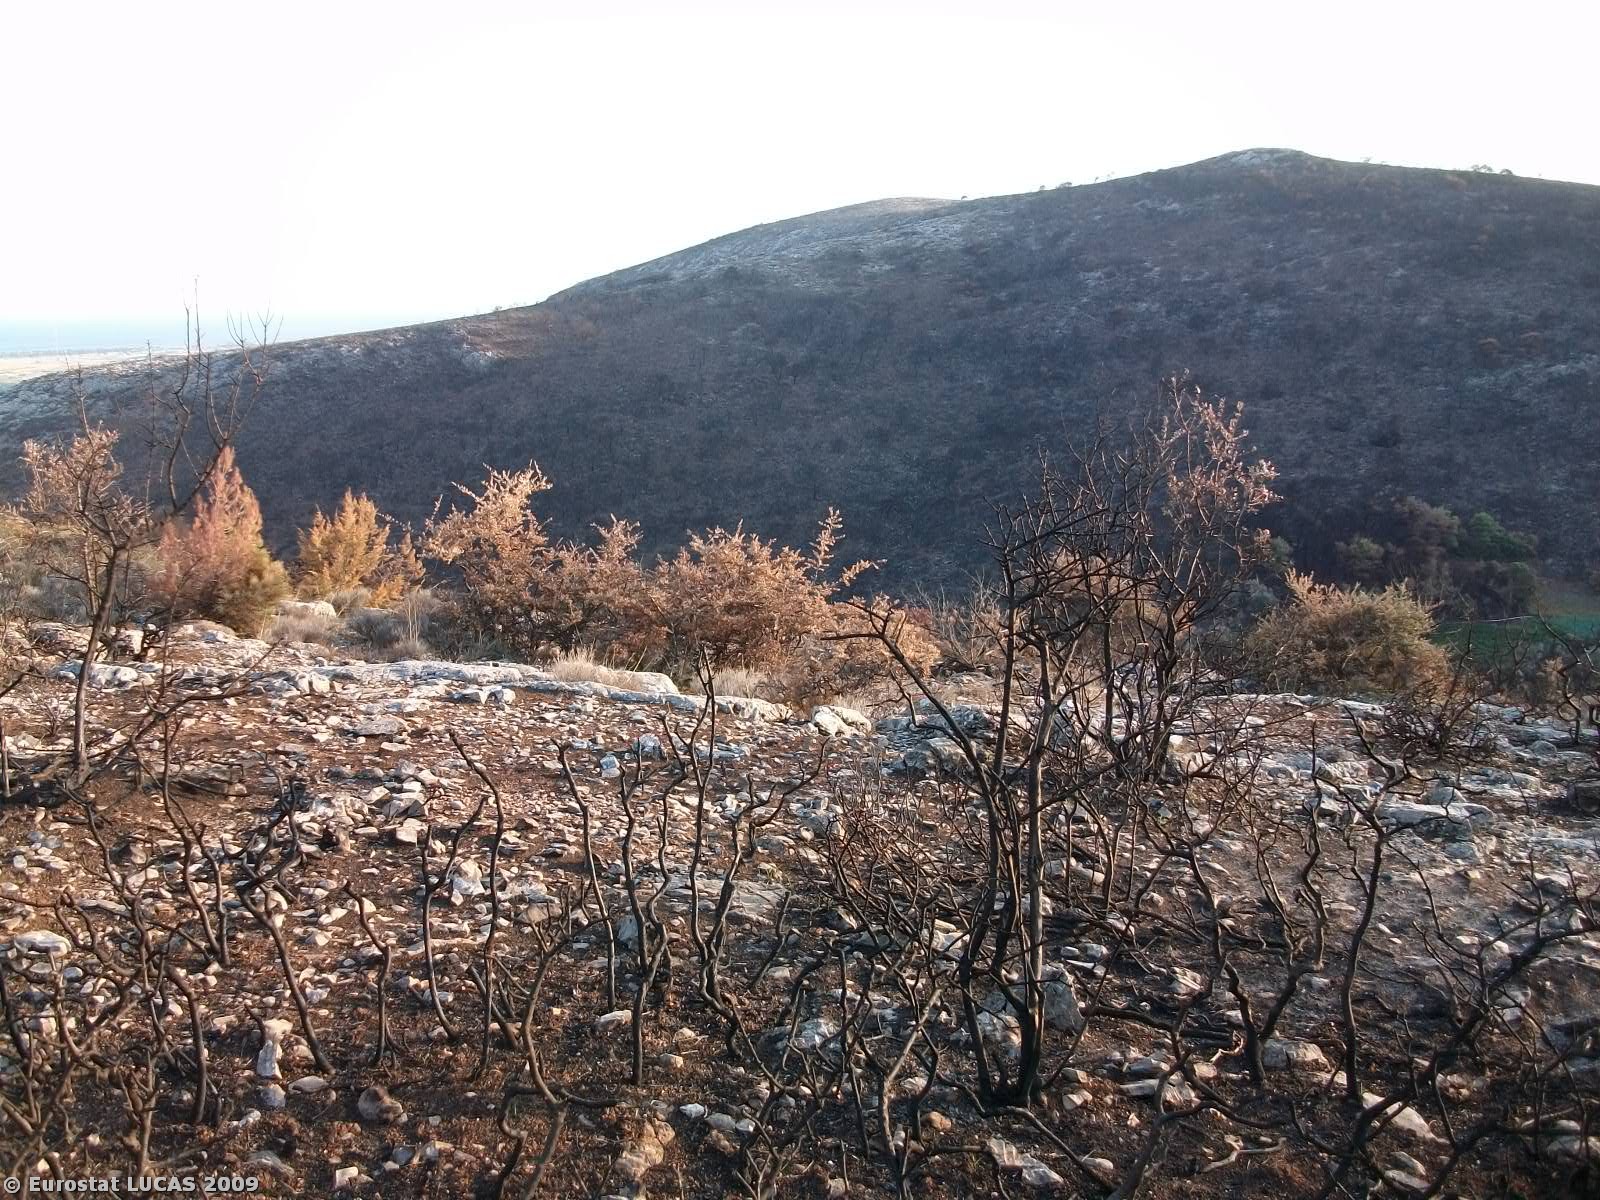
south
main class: Woodland
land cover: Mixed woodland
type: non-riverine alder, birch or aspen forest
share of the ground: < 10 %
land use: Forestry
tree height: > 5 m
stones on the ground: 25 - 50 %
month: September
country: GR
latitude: 38.1945
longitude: 23.9968
